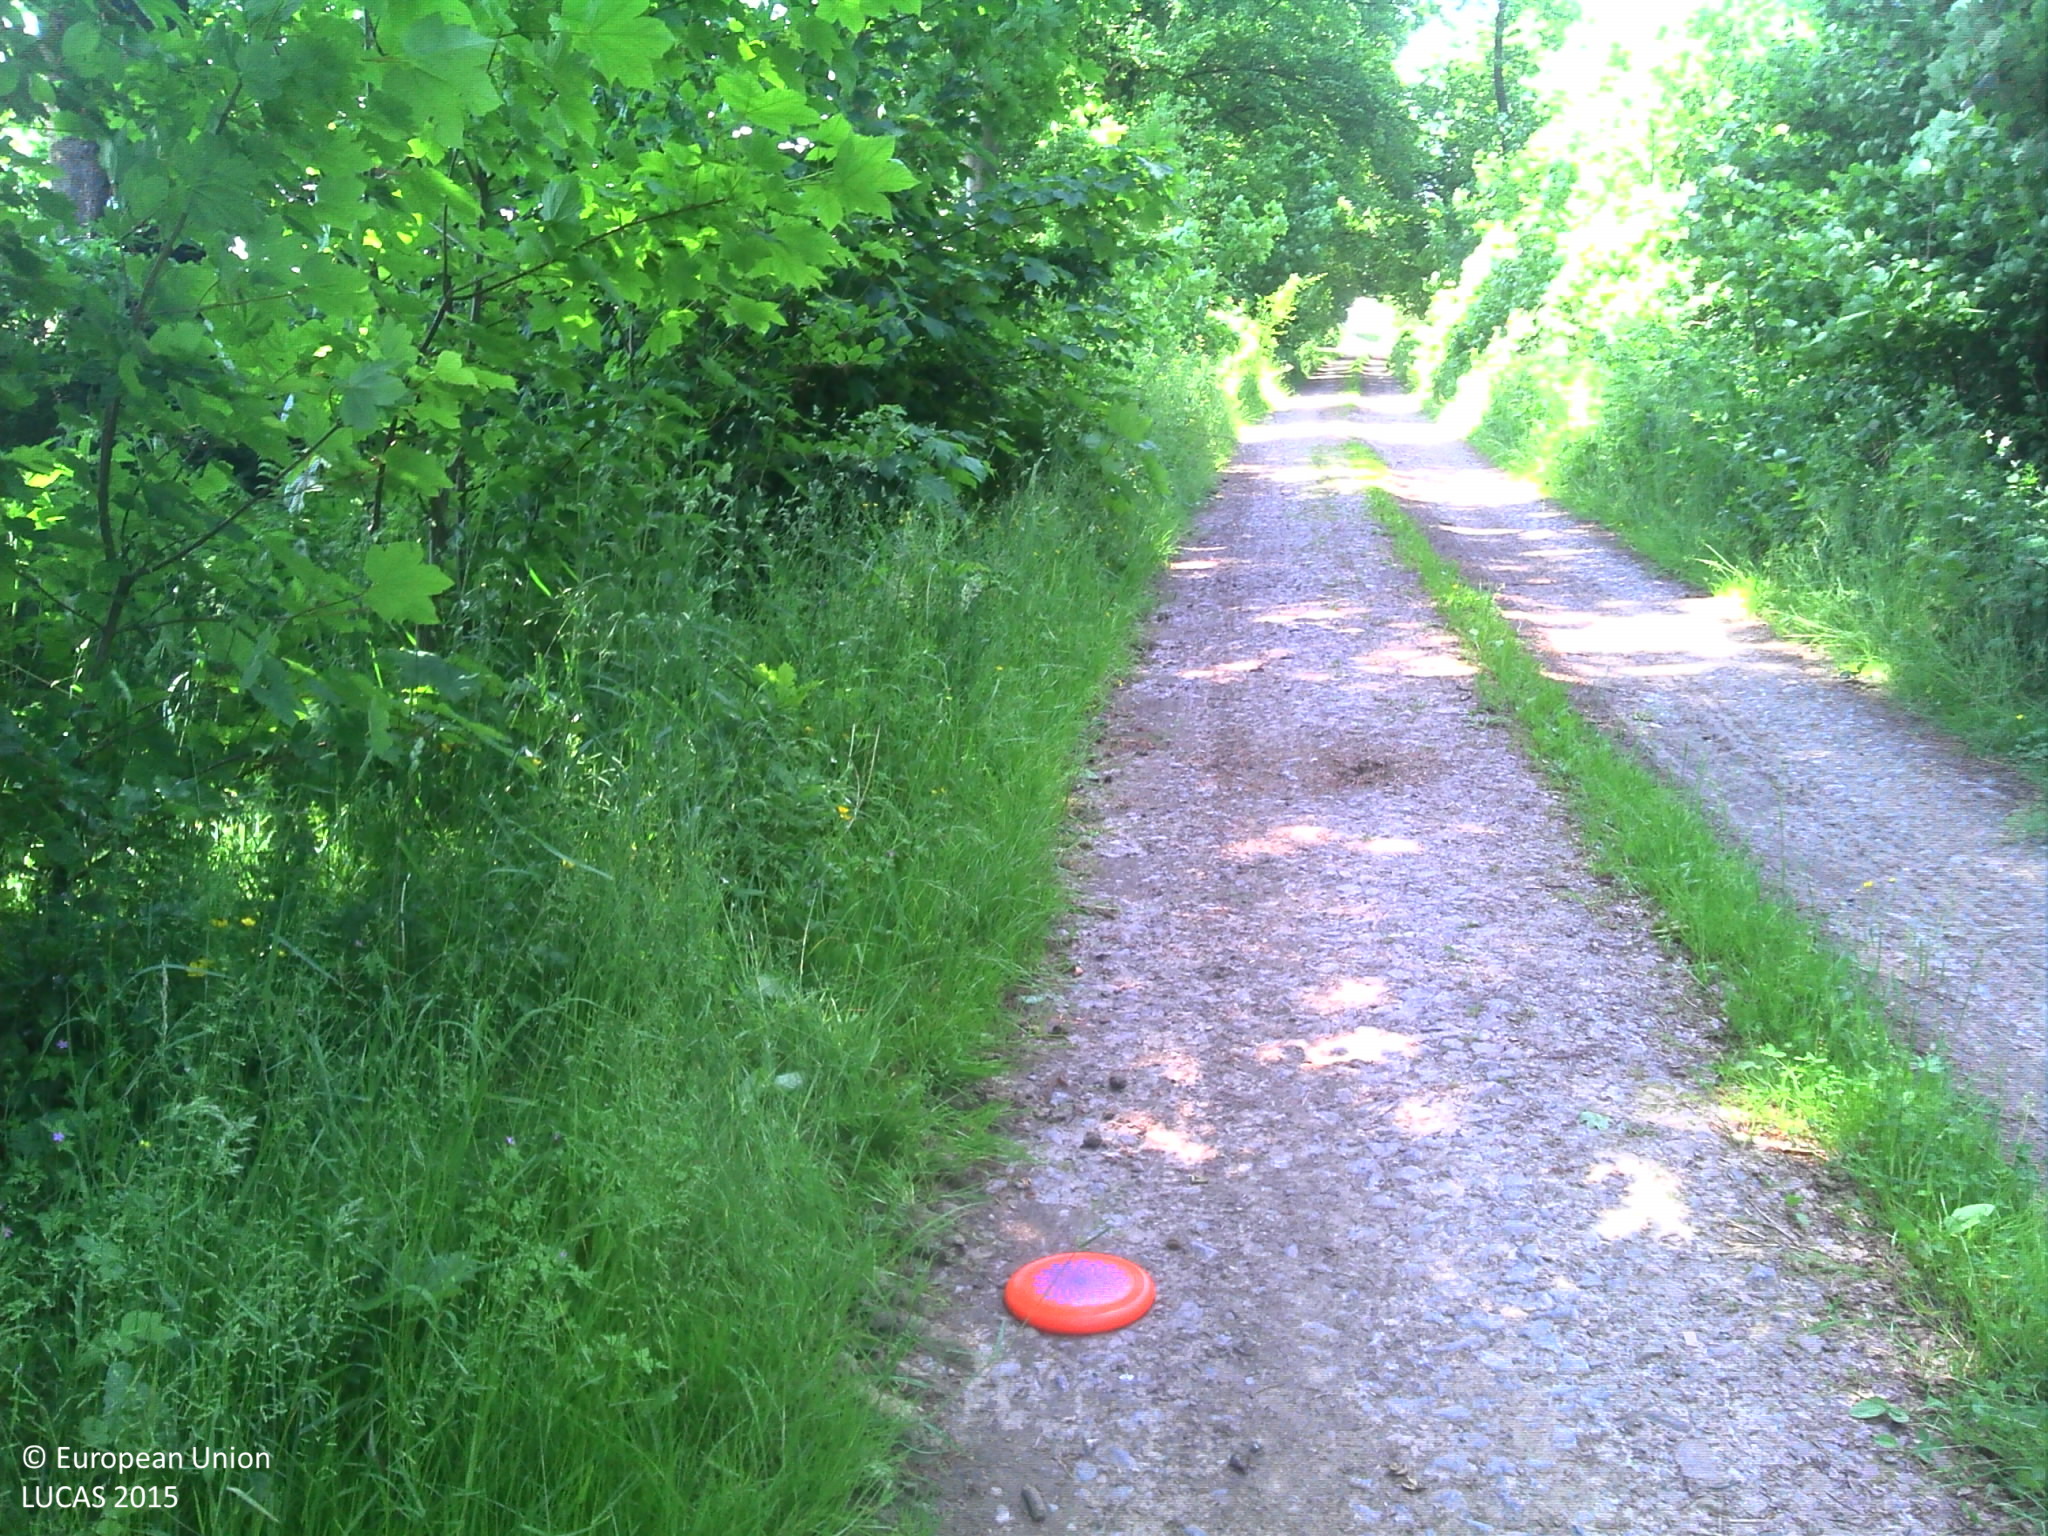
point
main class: Woodland
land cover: Broadleaved woodland
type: acidophilous oak and oak-birch forest
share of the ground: > 75 %
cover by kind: broadleaved forest trees 95 %, herbaceous plants 5 %
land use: Forestry
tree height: > 5 m
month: June
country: BE
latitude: 49.9788
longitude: 4.4877
